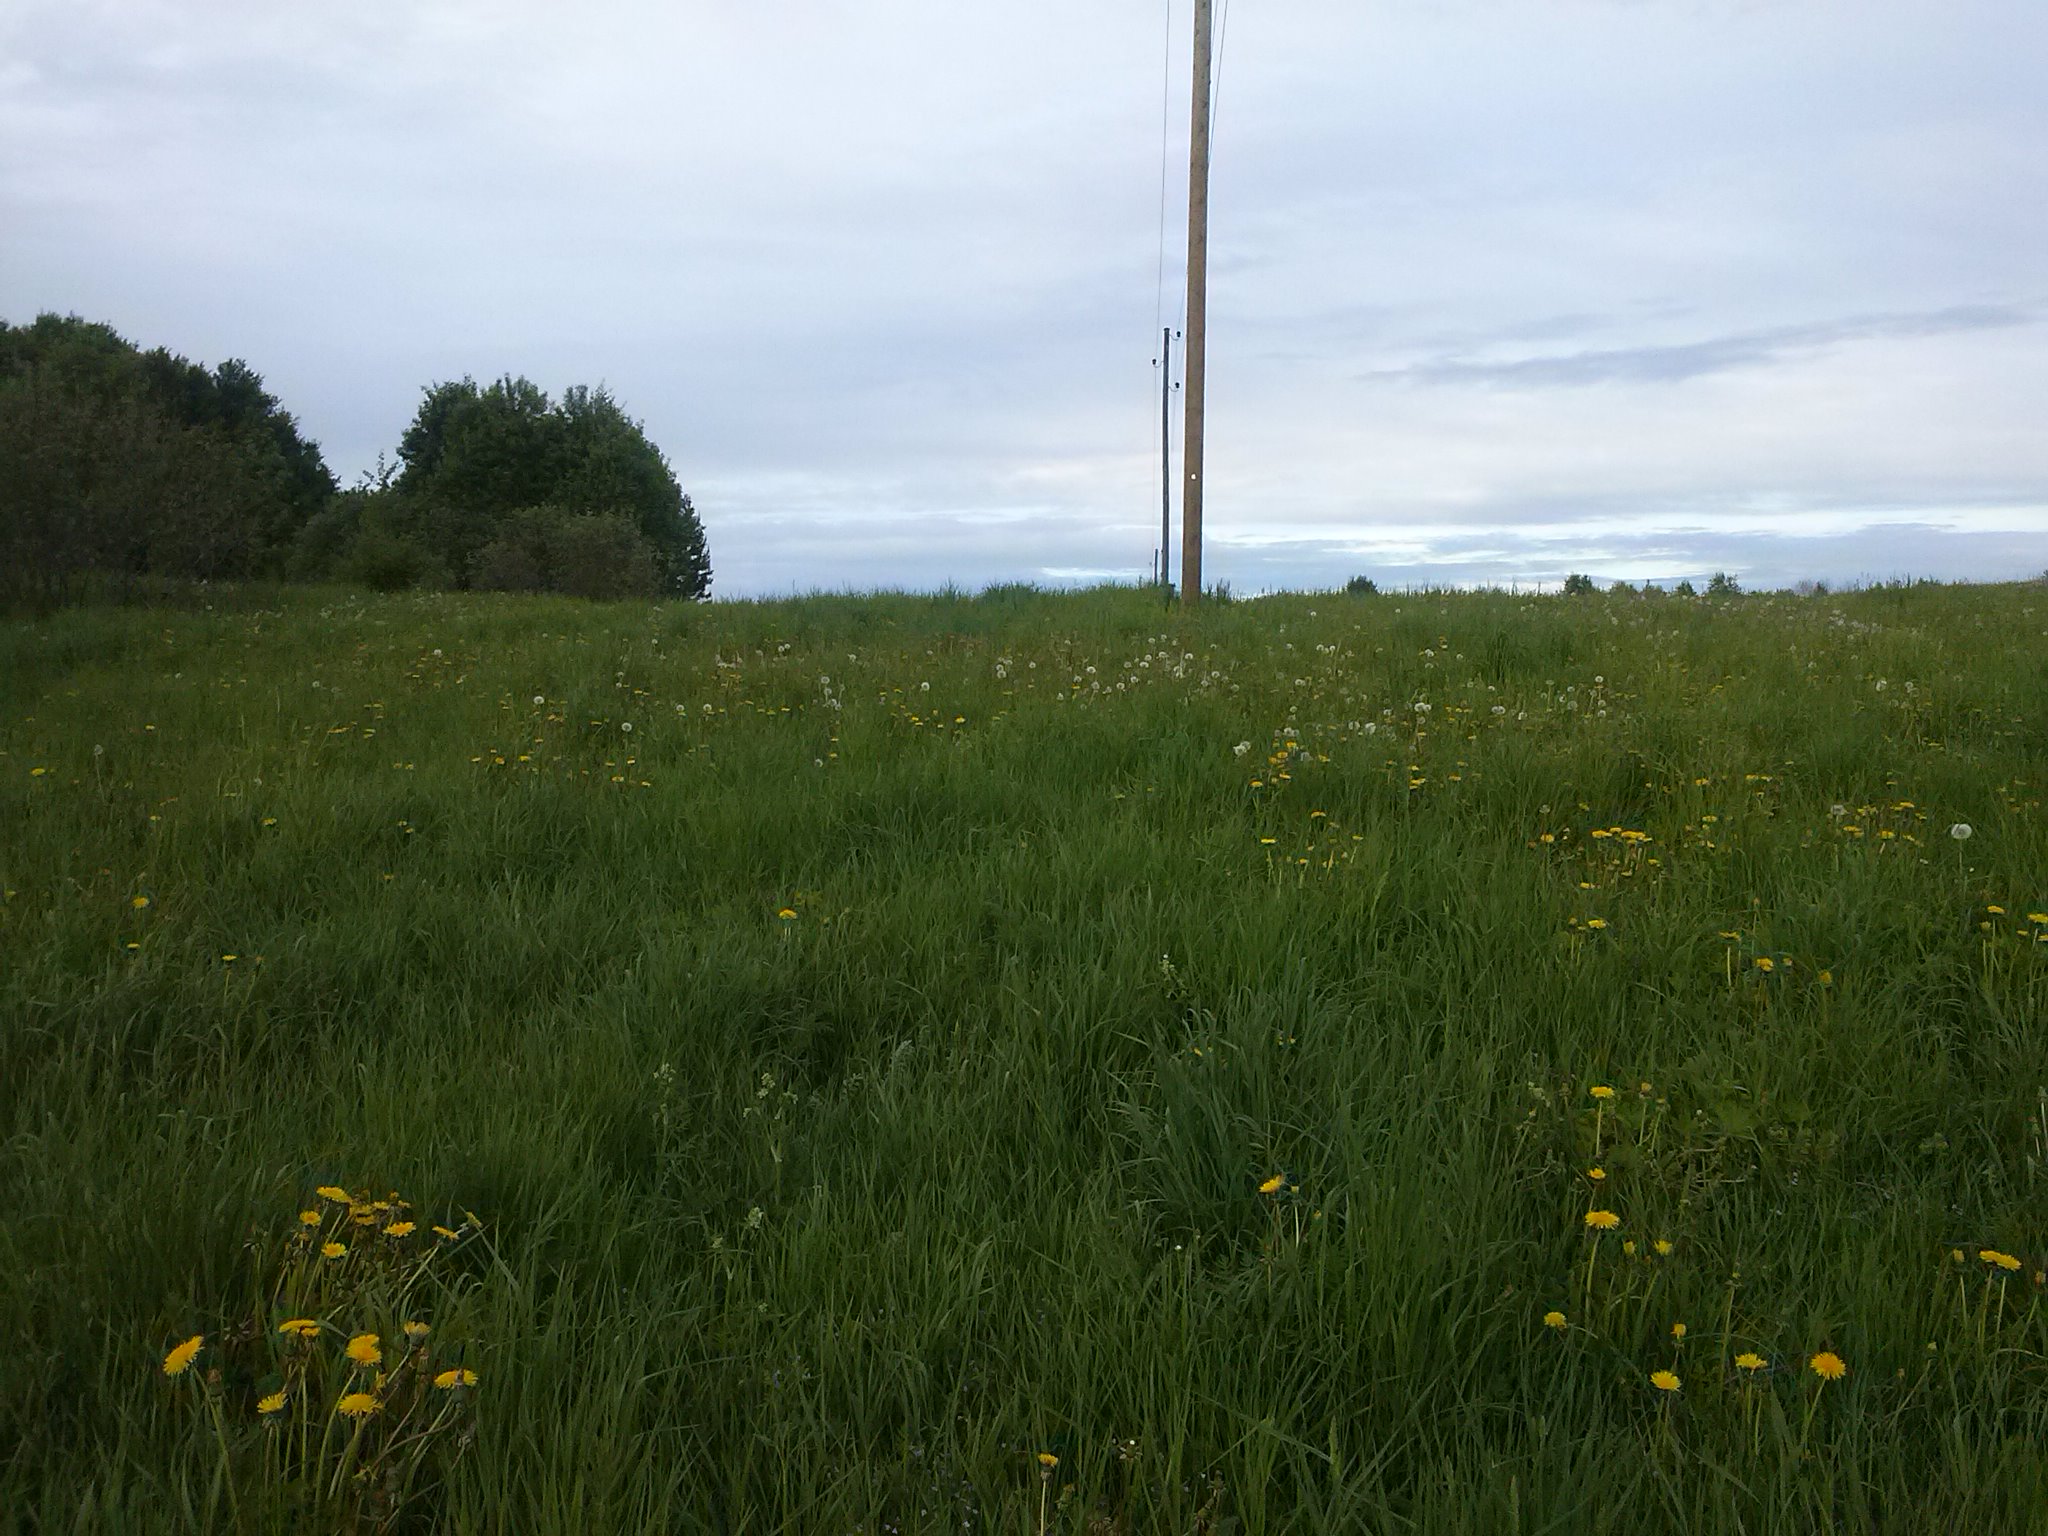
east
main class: Grassland
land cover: Grassland without tree/shrub cover
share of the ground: > 75 %
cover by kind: herbaceous plants 100 %
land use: Agriculture (excluding fallow land and kitchen gardens)
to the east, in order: Grassland without tree/shrub cover; Broadleaved woodland; Inland fresh water bodies; Broadleaved woodland; Spontaneously vegetated surfaces
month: May
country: LV
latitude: 56.2746
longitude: 27.8101
